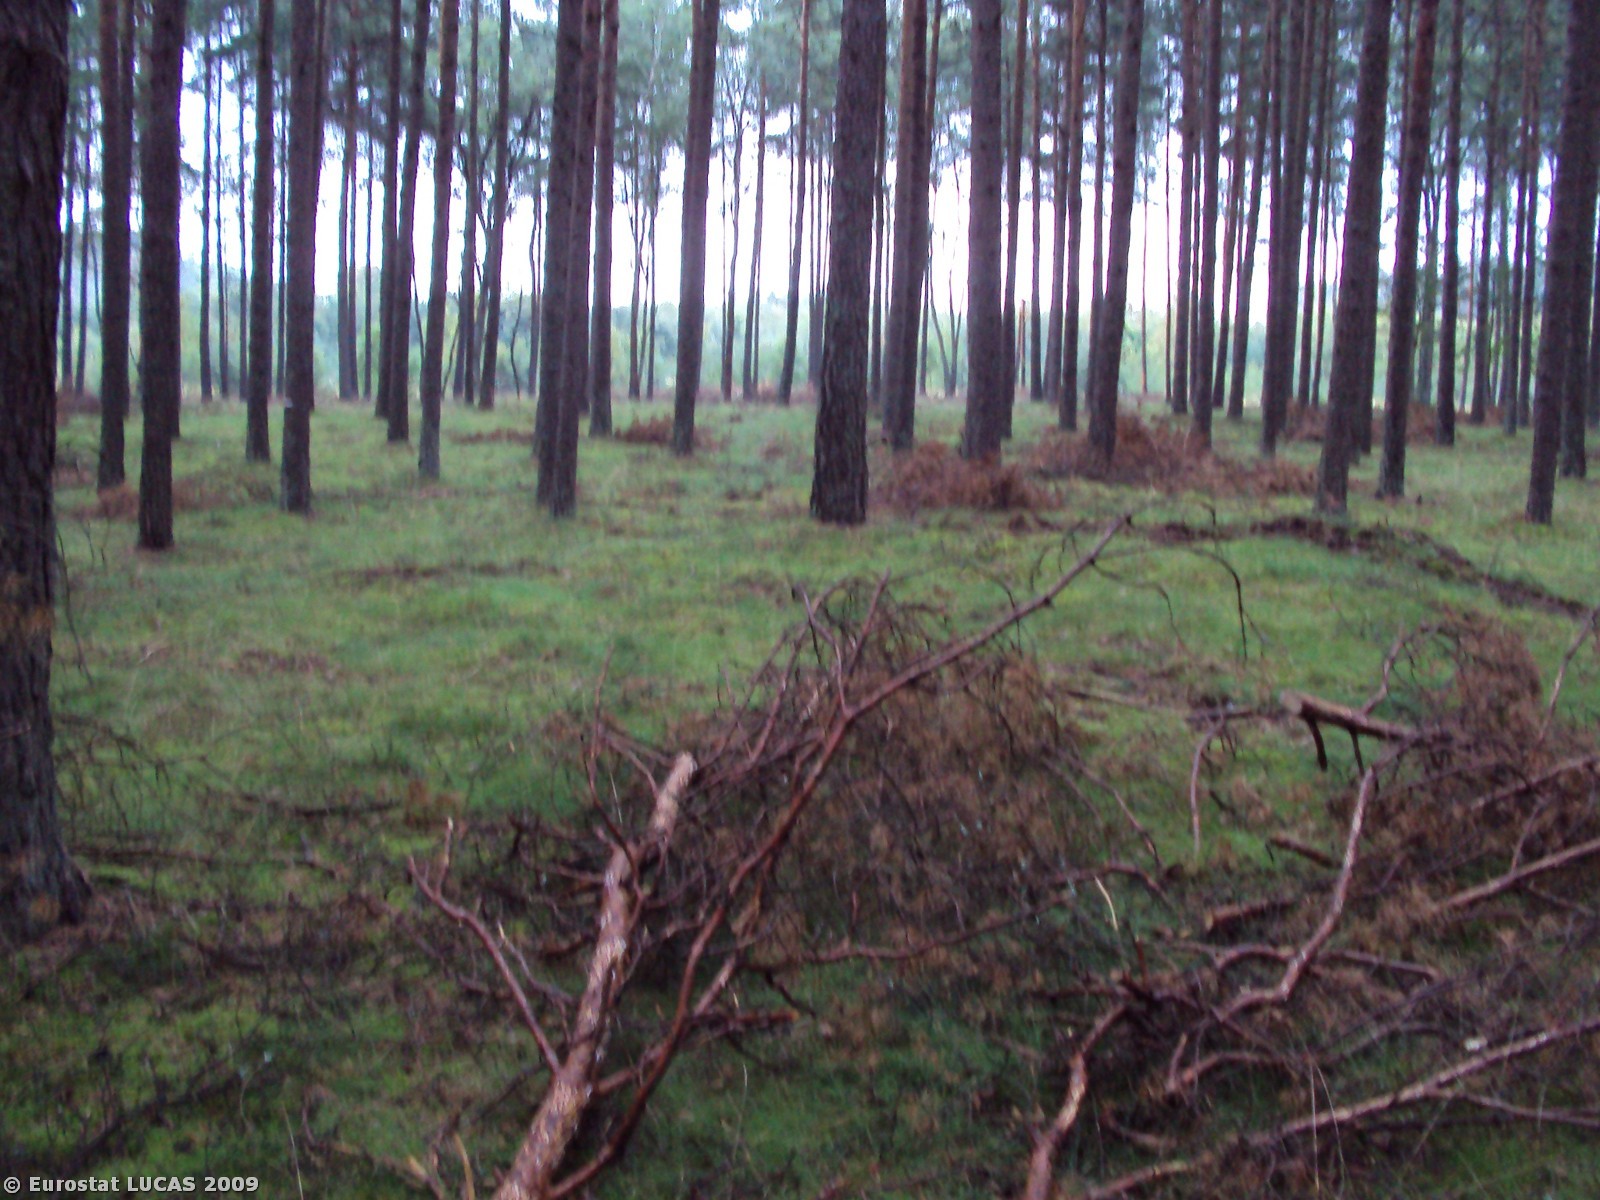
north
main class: Woodland
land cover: Coniferous woodland
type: hemiboreal forest and nemoral coniferous forest and mixed broadleaved-coniferous forest
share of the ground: > 75 %
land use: Forestry
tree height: > 5 m
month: August
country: PL
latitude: 53.2554
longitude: 15.9557
